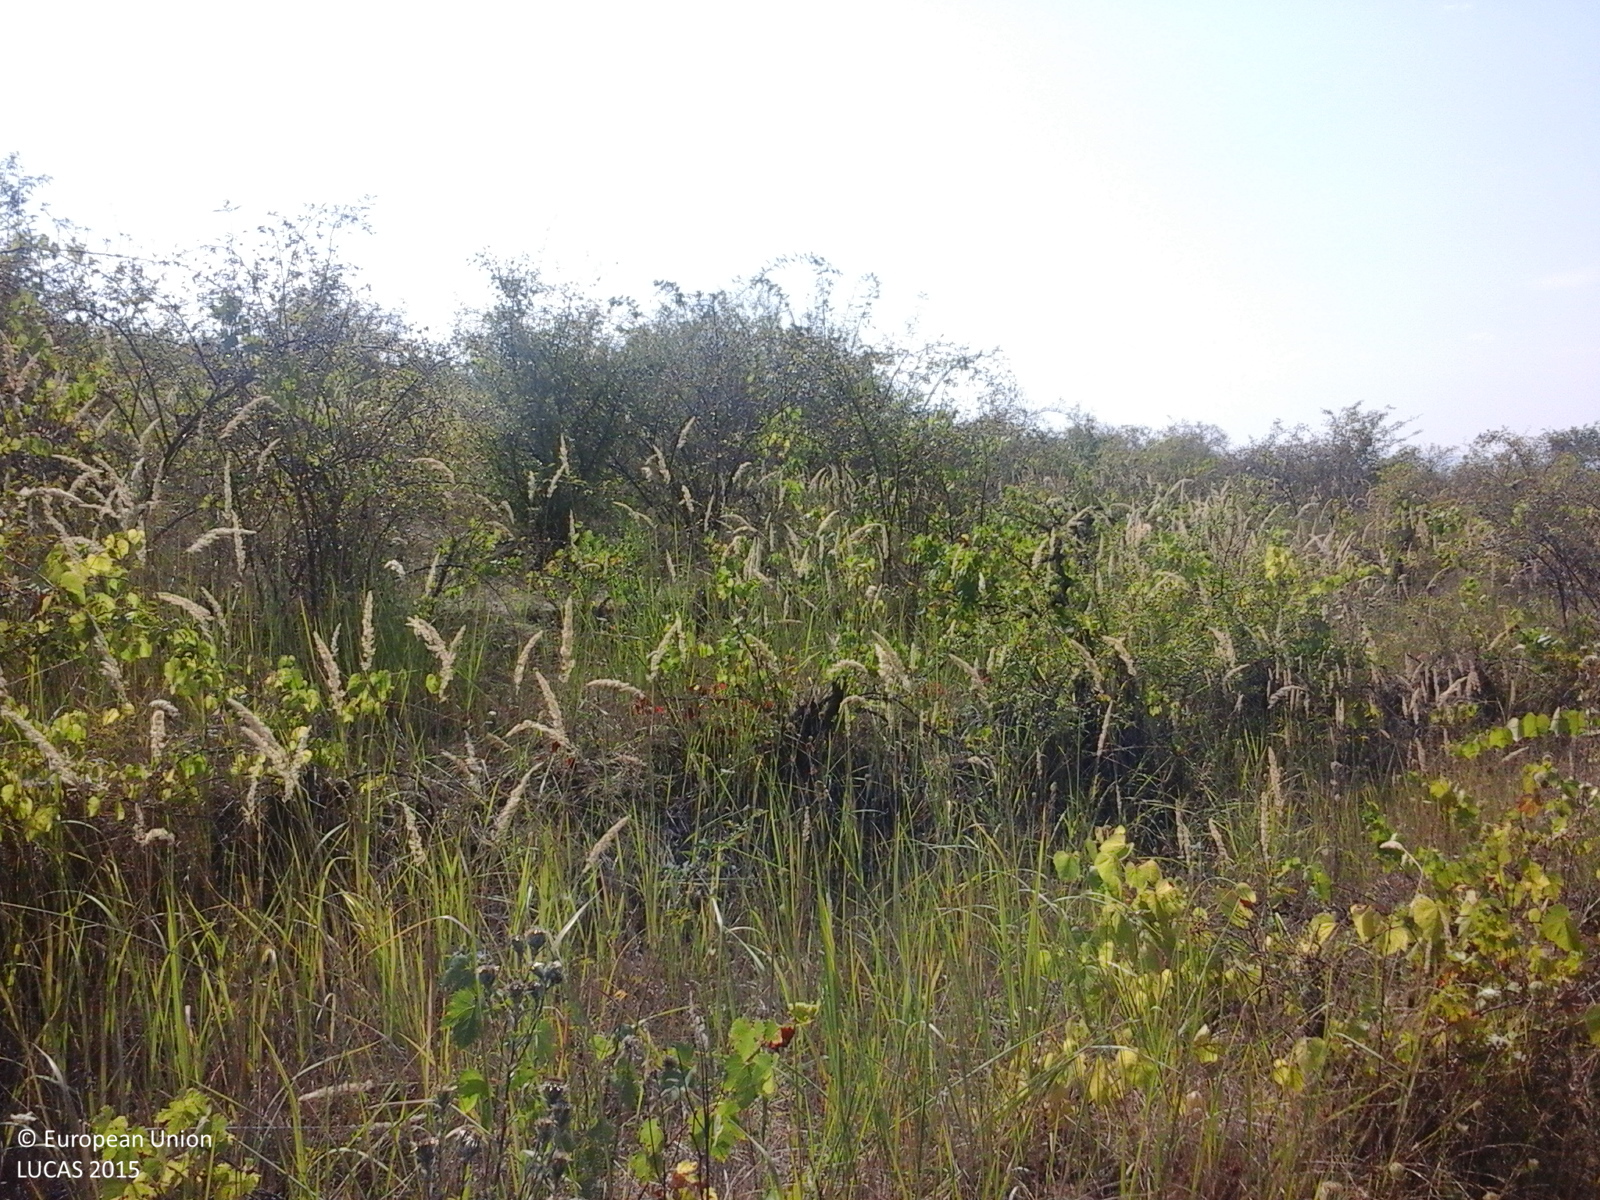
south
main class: Cropland
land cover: Vineyards
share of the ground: > 75 %
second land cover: Spontaneously vegetated surfaces
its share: > 75 %
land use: Agriculture (excluding fallow land and kitchen gardens)
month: August
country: RO
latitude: 46.3595
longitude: 21.8821
